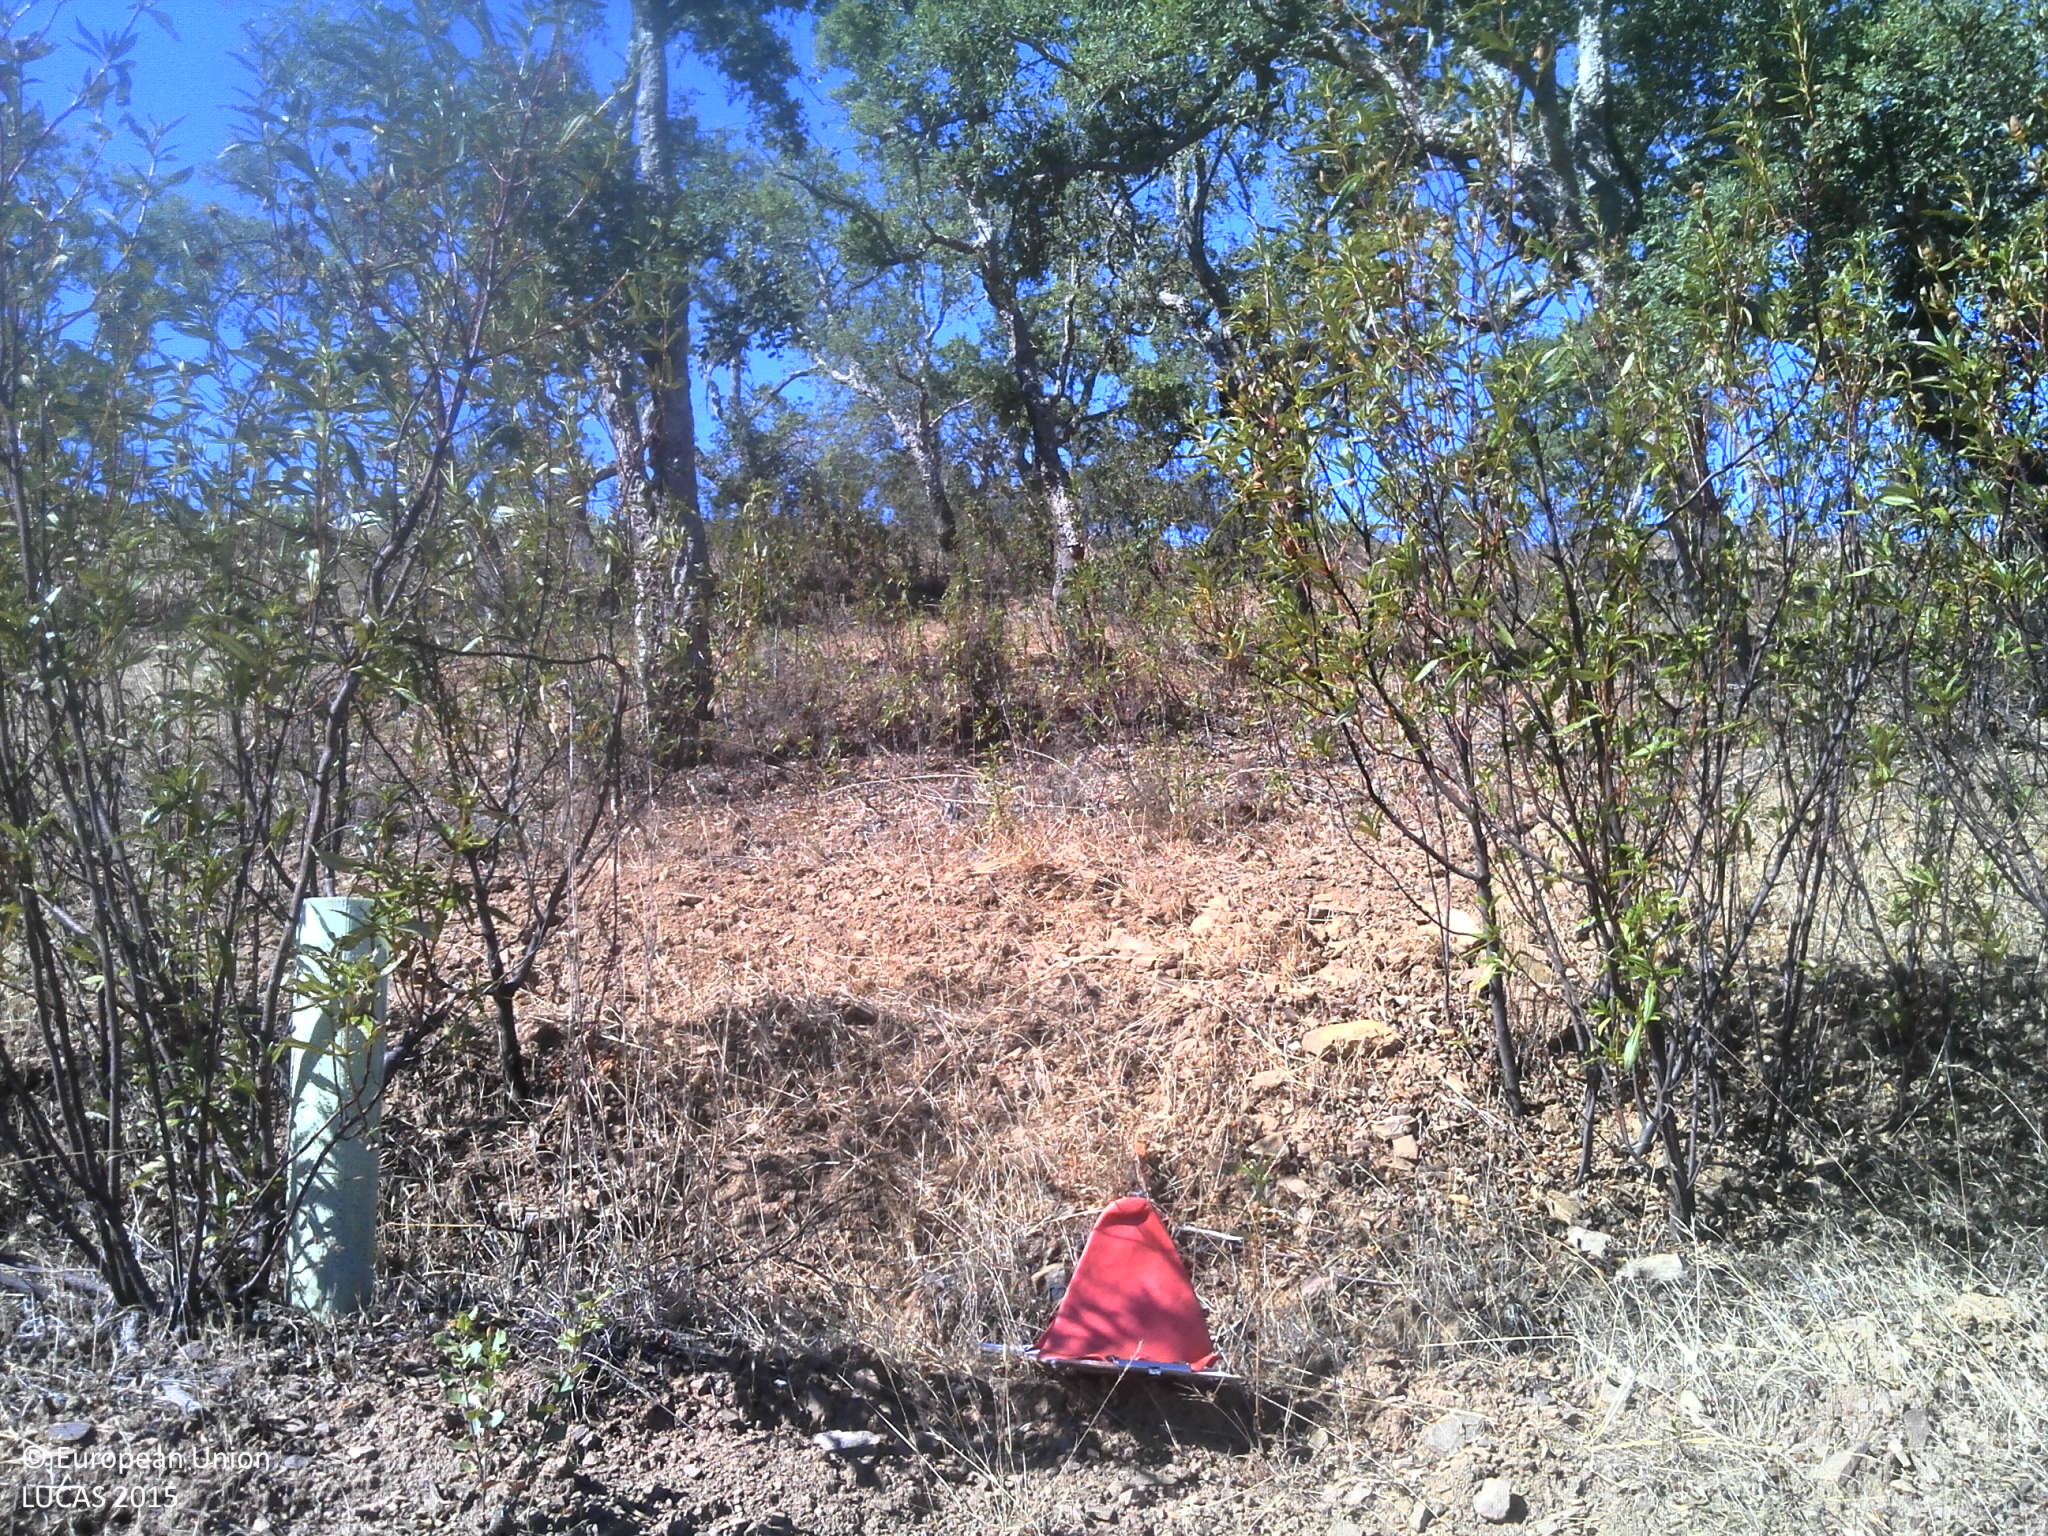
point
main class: Woodland
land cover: Broadleaved woodland
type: broadleaved evergreen forest
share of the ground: 25 - 50 %
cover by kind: unconsolidated bare surface 40 %, broadleaved forest trees 30 %, shrubs 30 %
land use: Forestry
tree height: > 5 m
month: August
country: PT
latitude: 37.1831
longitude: -8.7412
